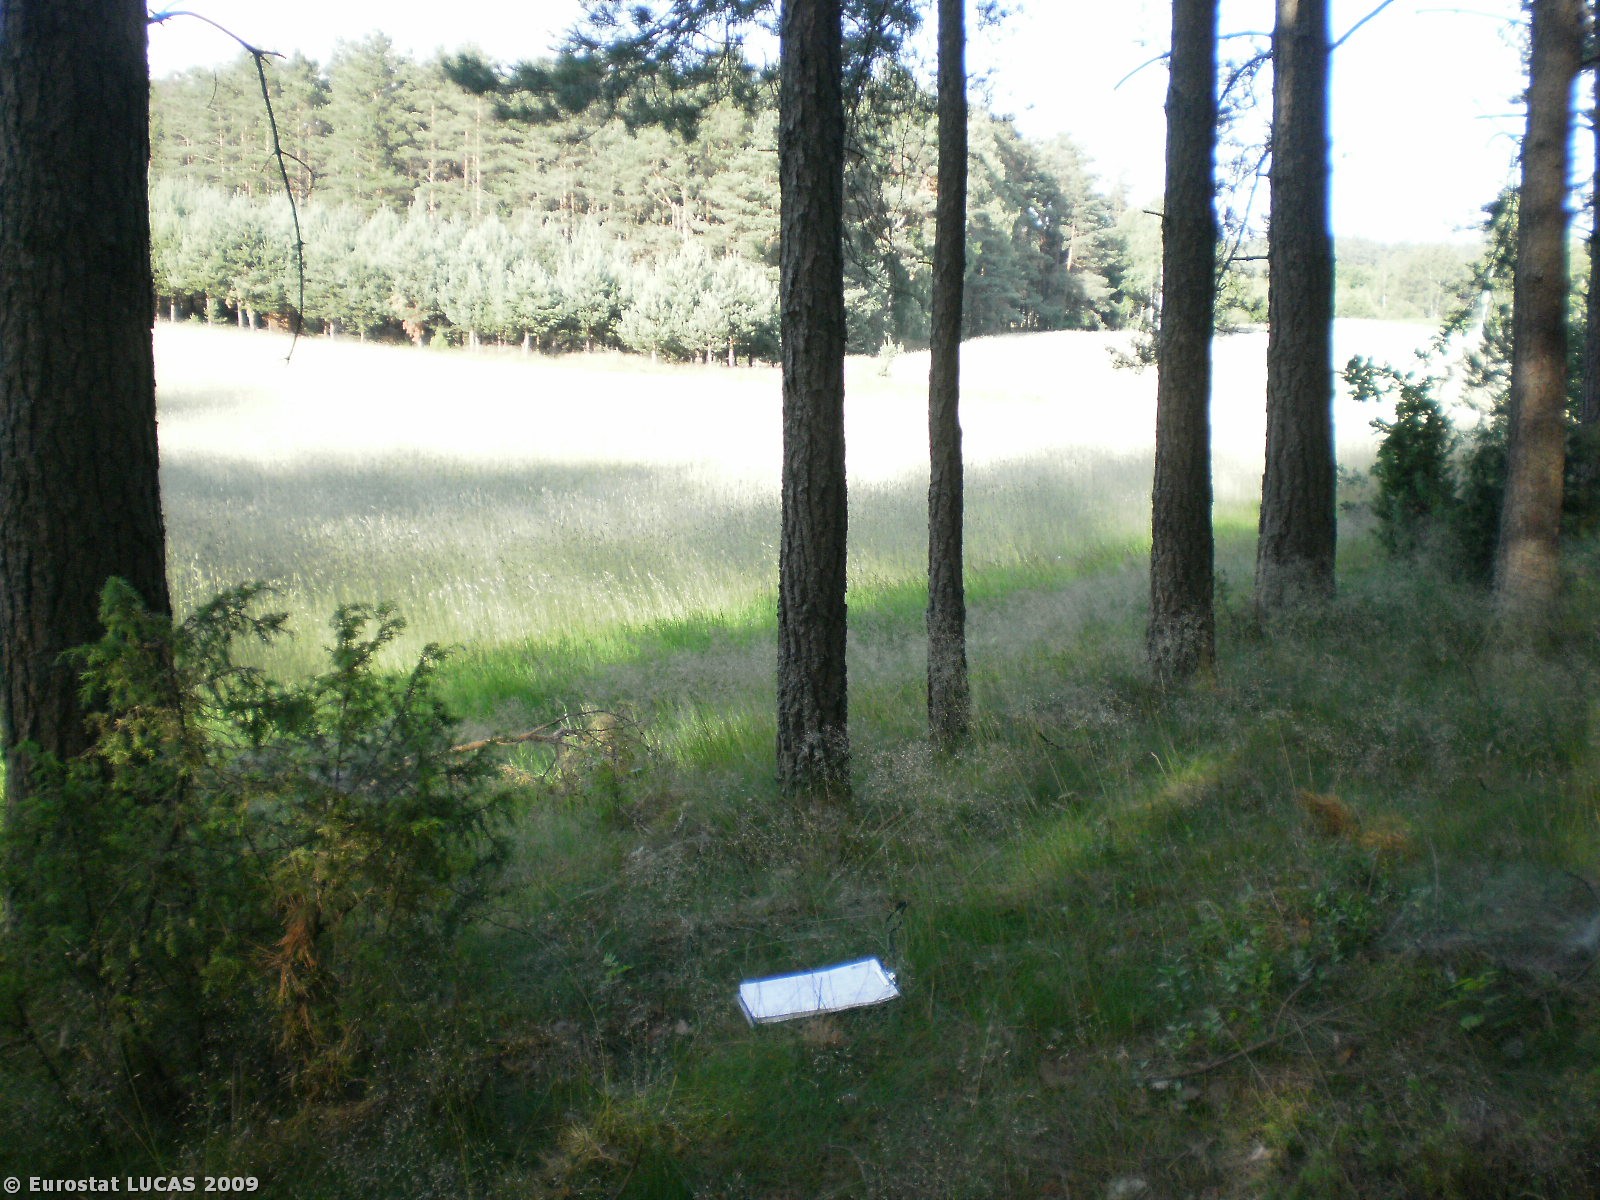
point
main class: Cropland
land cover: Arable land (only in case pi)
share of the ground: > 75 %
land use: Agriculture (excluding fallow land and kitchen gardens)
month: July
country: PL
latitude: 54.1076
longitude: 17.7980
